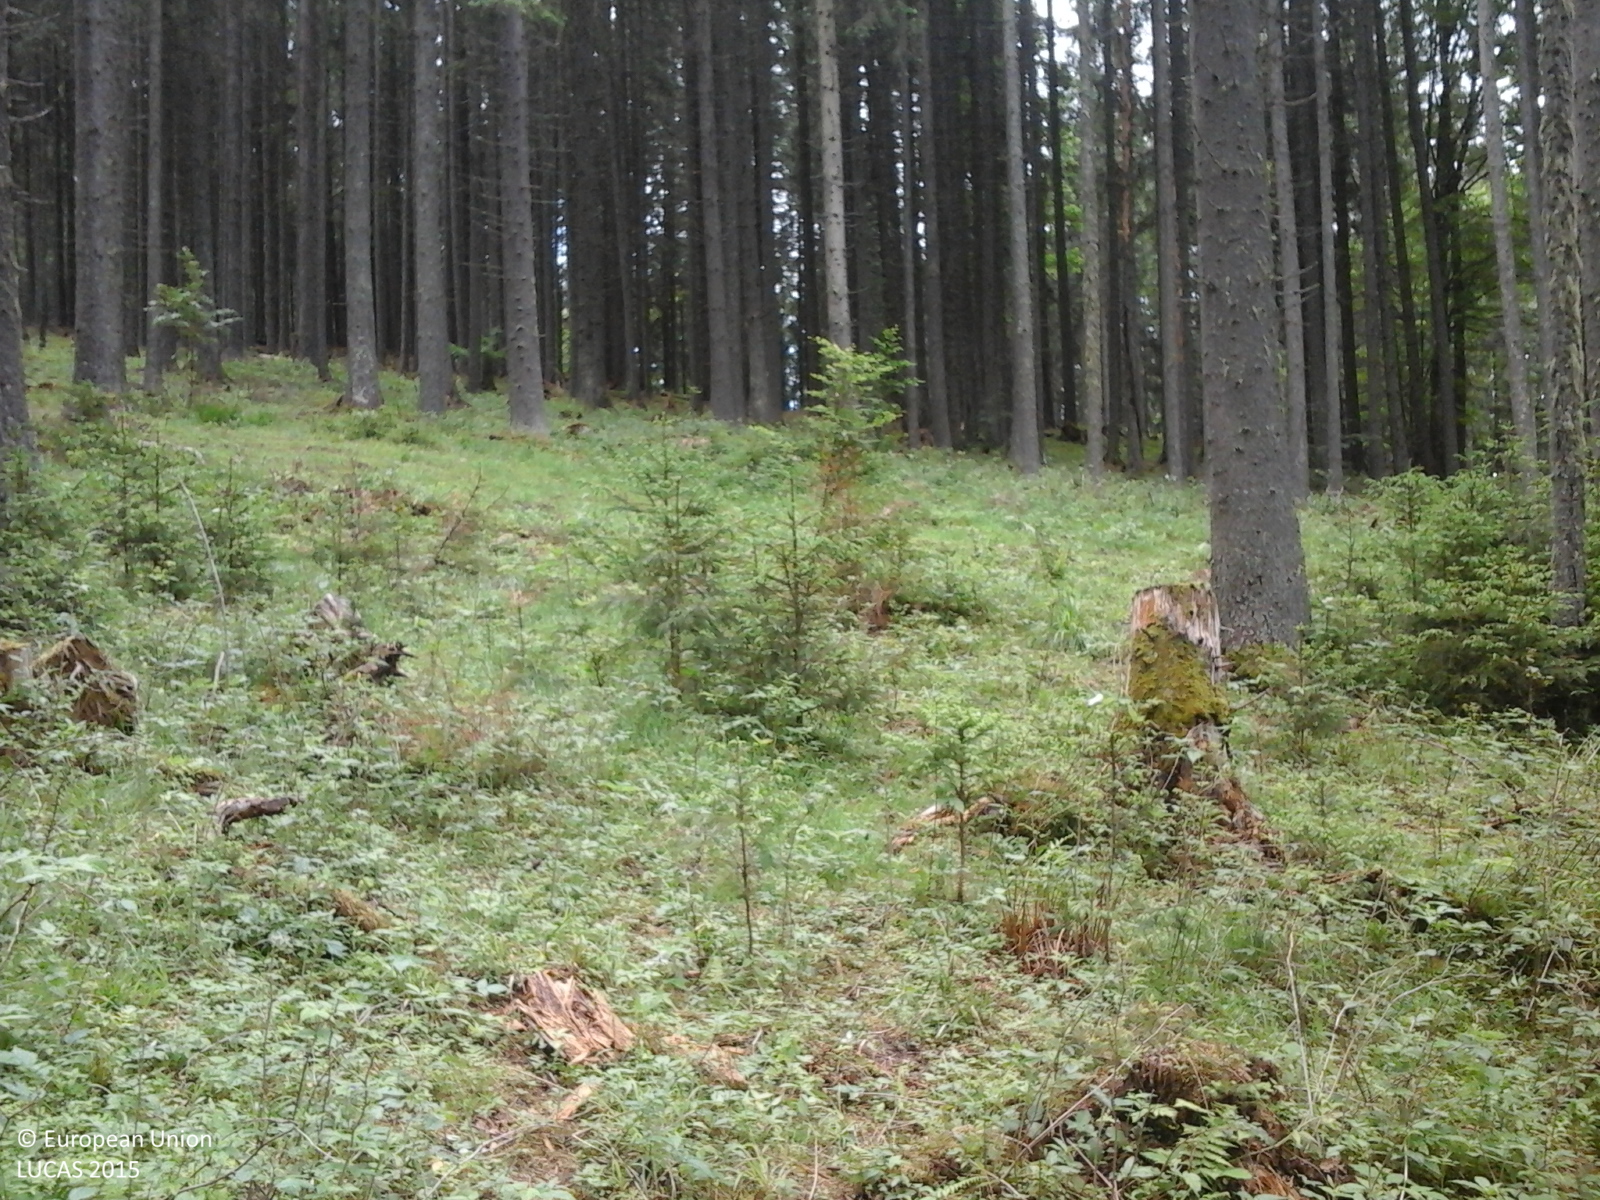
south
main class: Woodland
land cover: Spruce dominated coniferous woodland
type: alpine coniferous forest
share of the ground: > 75 %
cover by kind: coniferous forest trees 100 %
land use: Forestry
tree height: > 5 m
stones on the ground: < 10 %
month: June
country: RO
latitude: 47.4069
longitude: 25.1480
